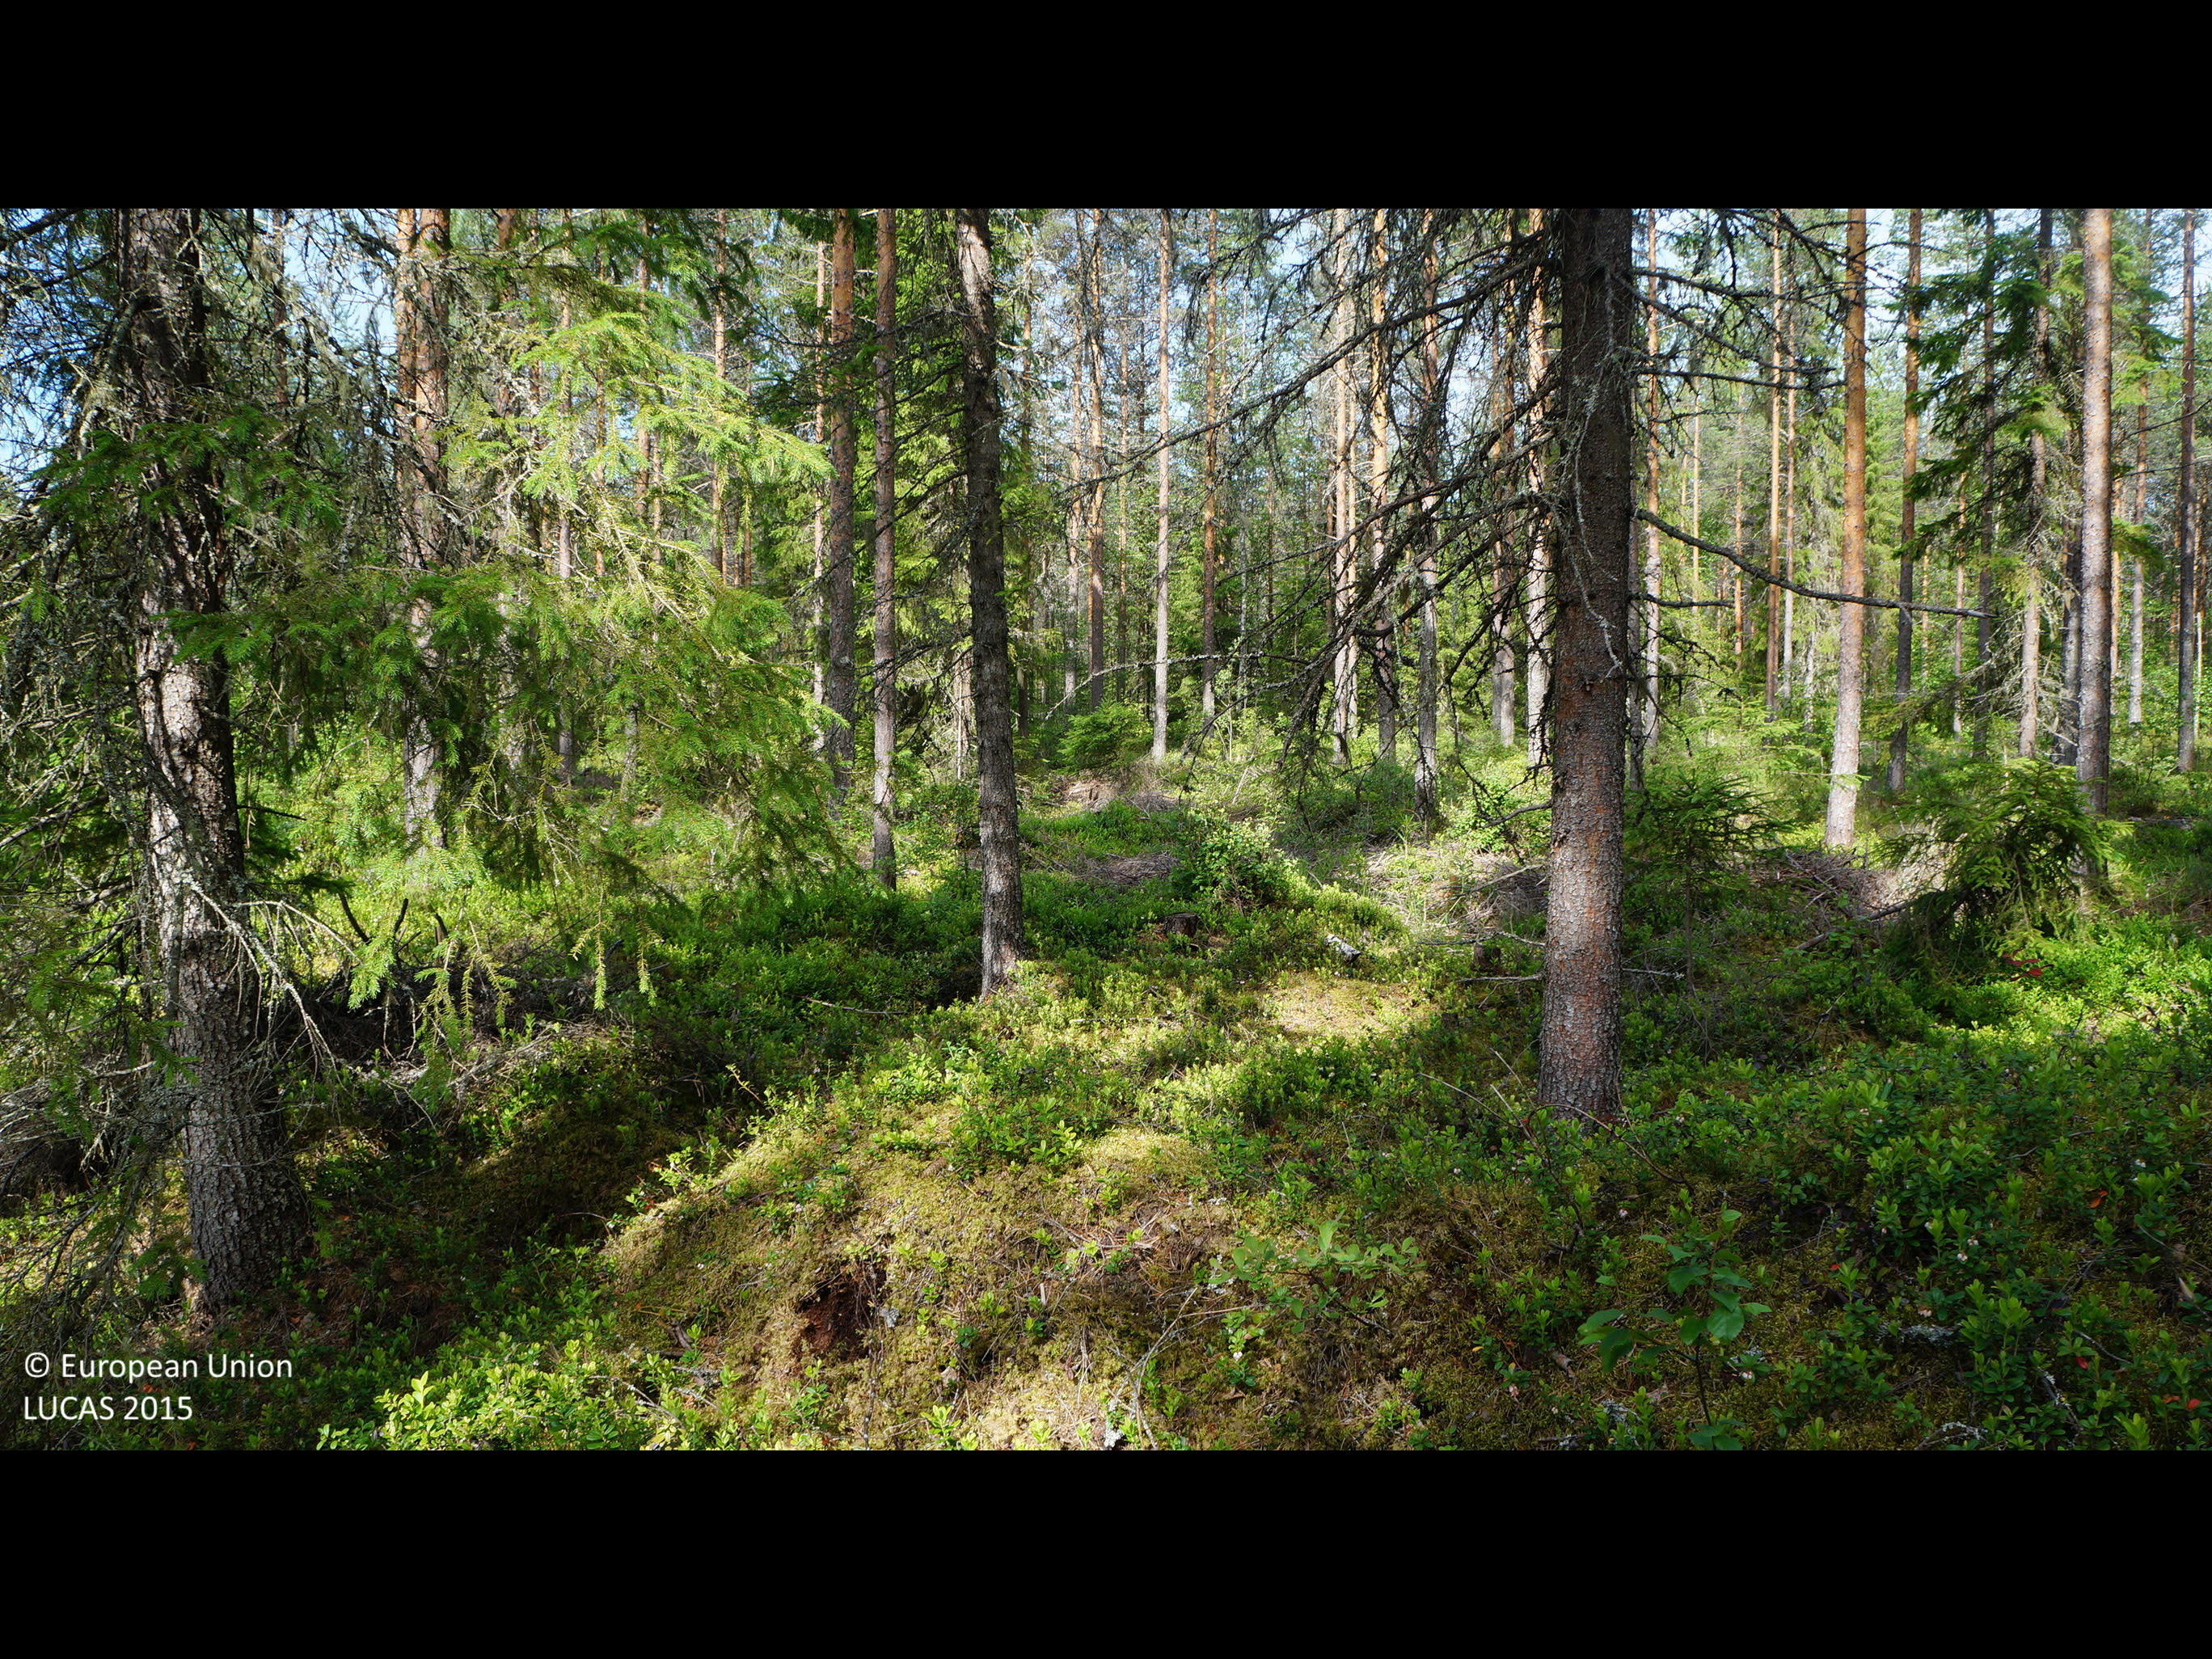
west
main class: Woodland
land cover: Spruce dominated coniferous woodland
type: boreal forest
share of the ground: 50 - 75 %
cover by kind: coniferous forest trees 50 %, shrubs 35 %, lichens and mosses 10 %, broadleaved forest trees 5 %
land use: Forestry
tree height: > 5 m
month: July
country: FI
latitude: 64.3462
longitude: 24.5847
